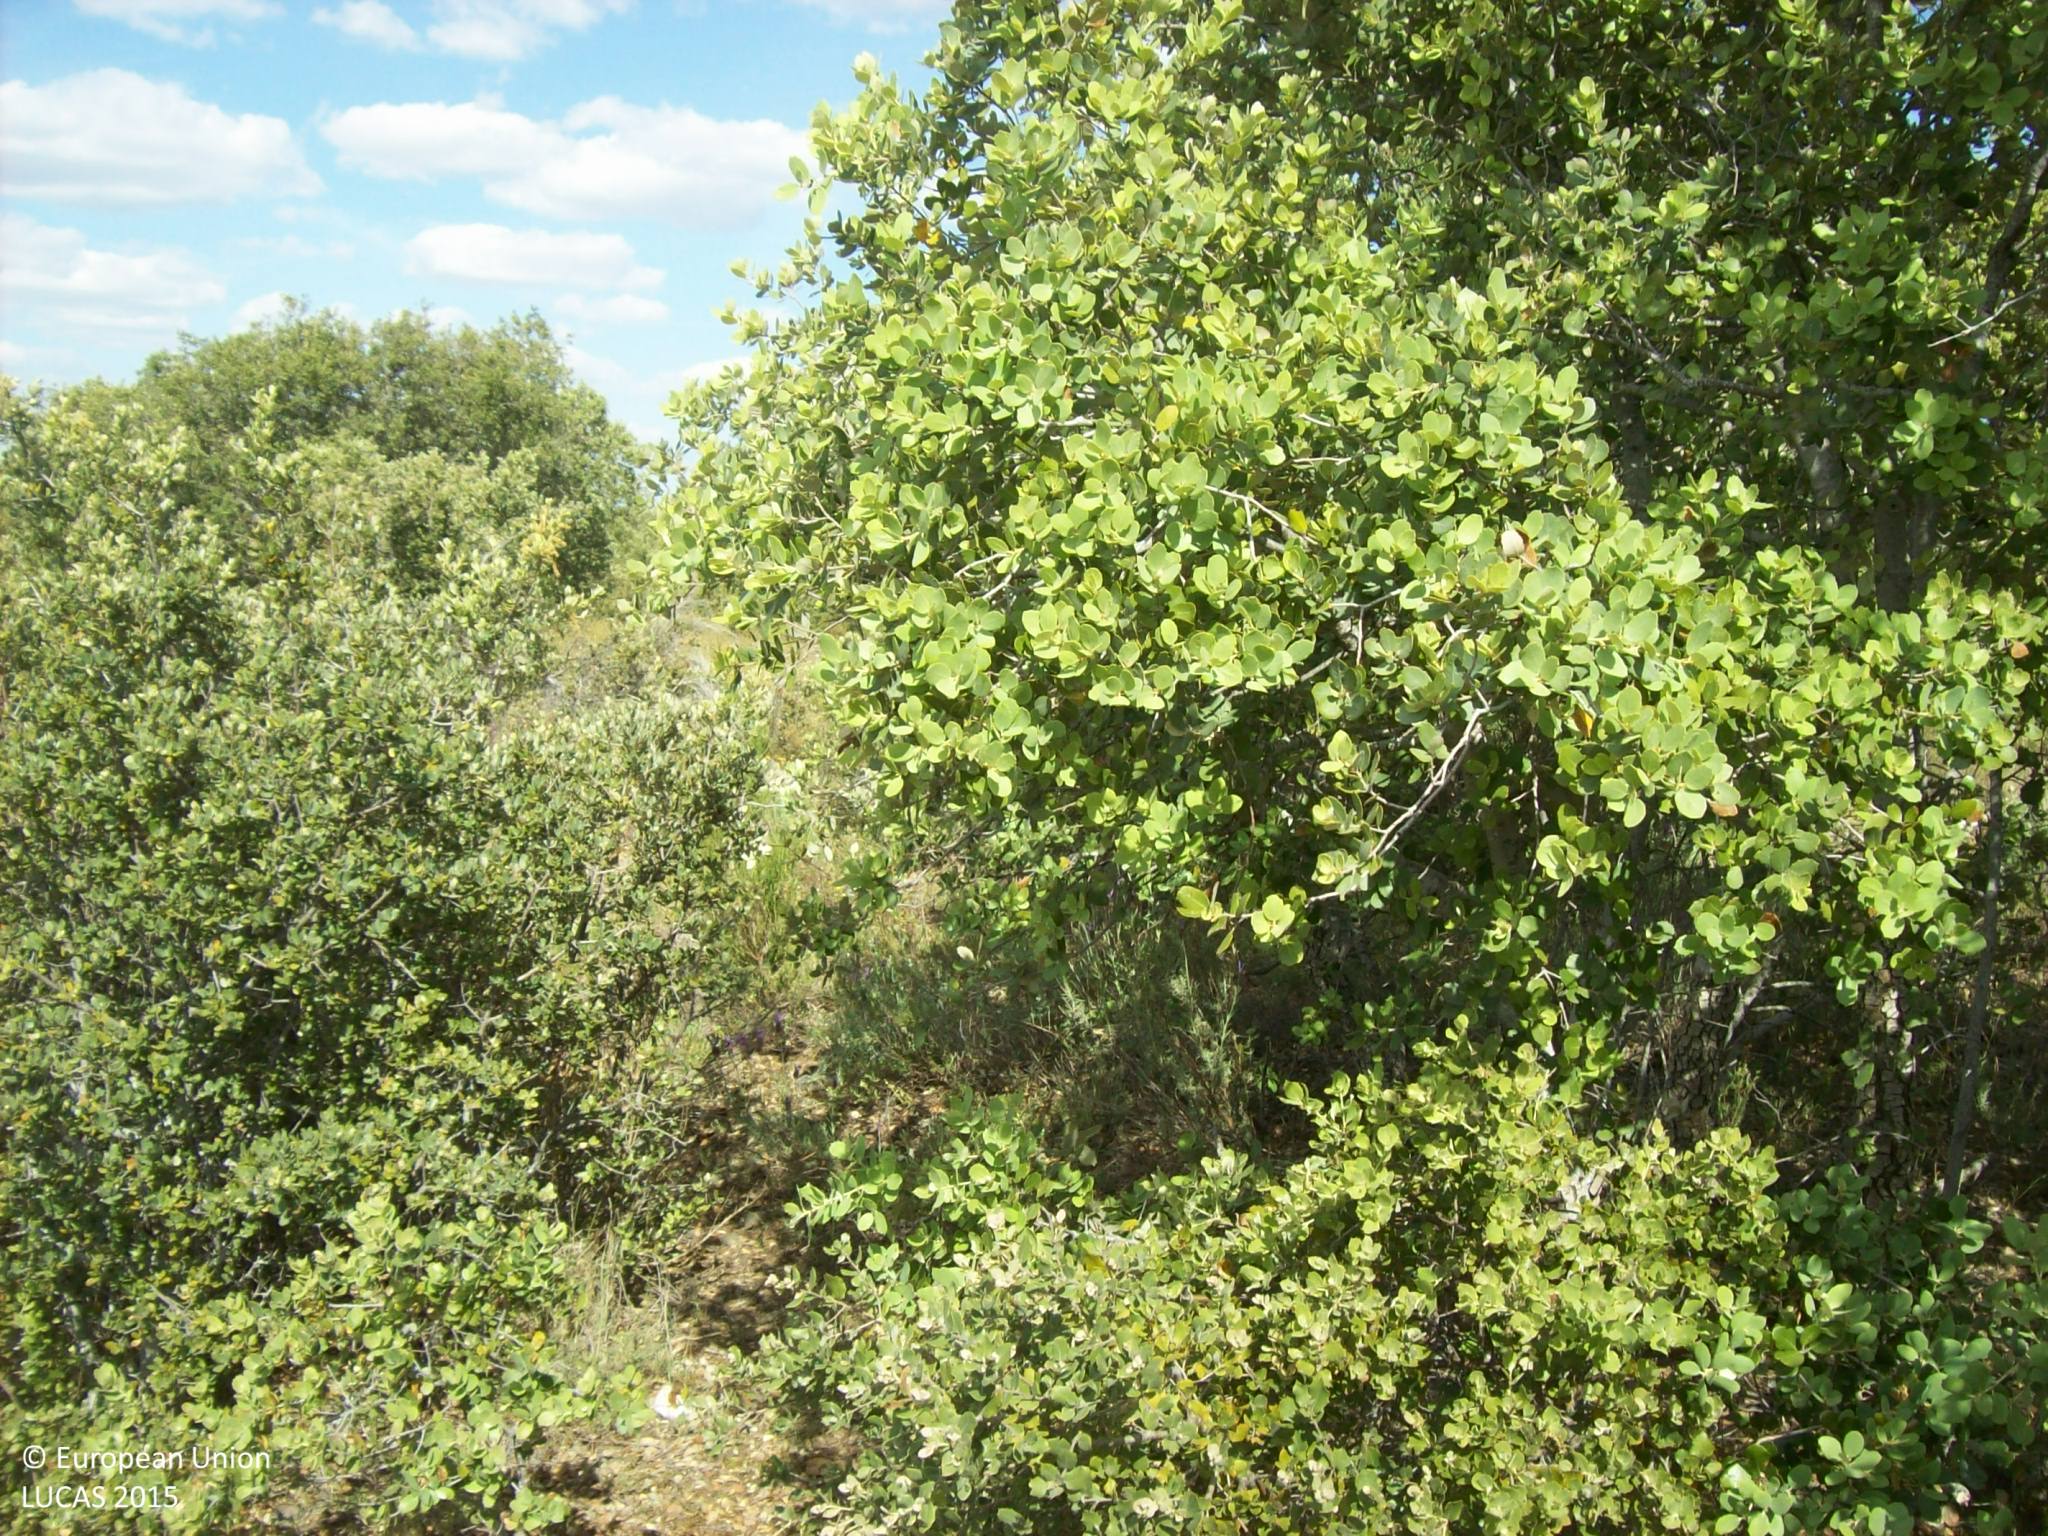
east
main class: Woodland
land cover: Broadleaved woodland
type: broadleaved evergreen forest
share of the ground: 50 - 75 %
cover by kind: broadleaved forest trees 60 %, herbaceous plants 15 %, shrubs 10 %, unconsolidated bare surface 10 %, lichens and mosses 5 %
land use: Forestry
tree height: > 5 m
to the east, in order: Broadleaved woodland; Tracks; Fences; Broadleaved woodland
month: May
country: ES
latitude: 40.8685
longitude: -4.5188
